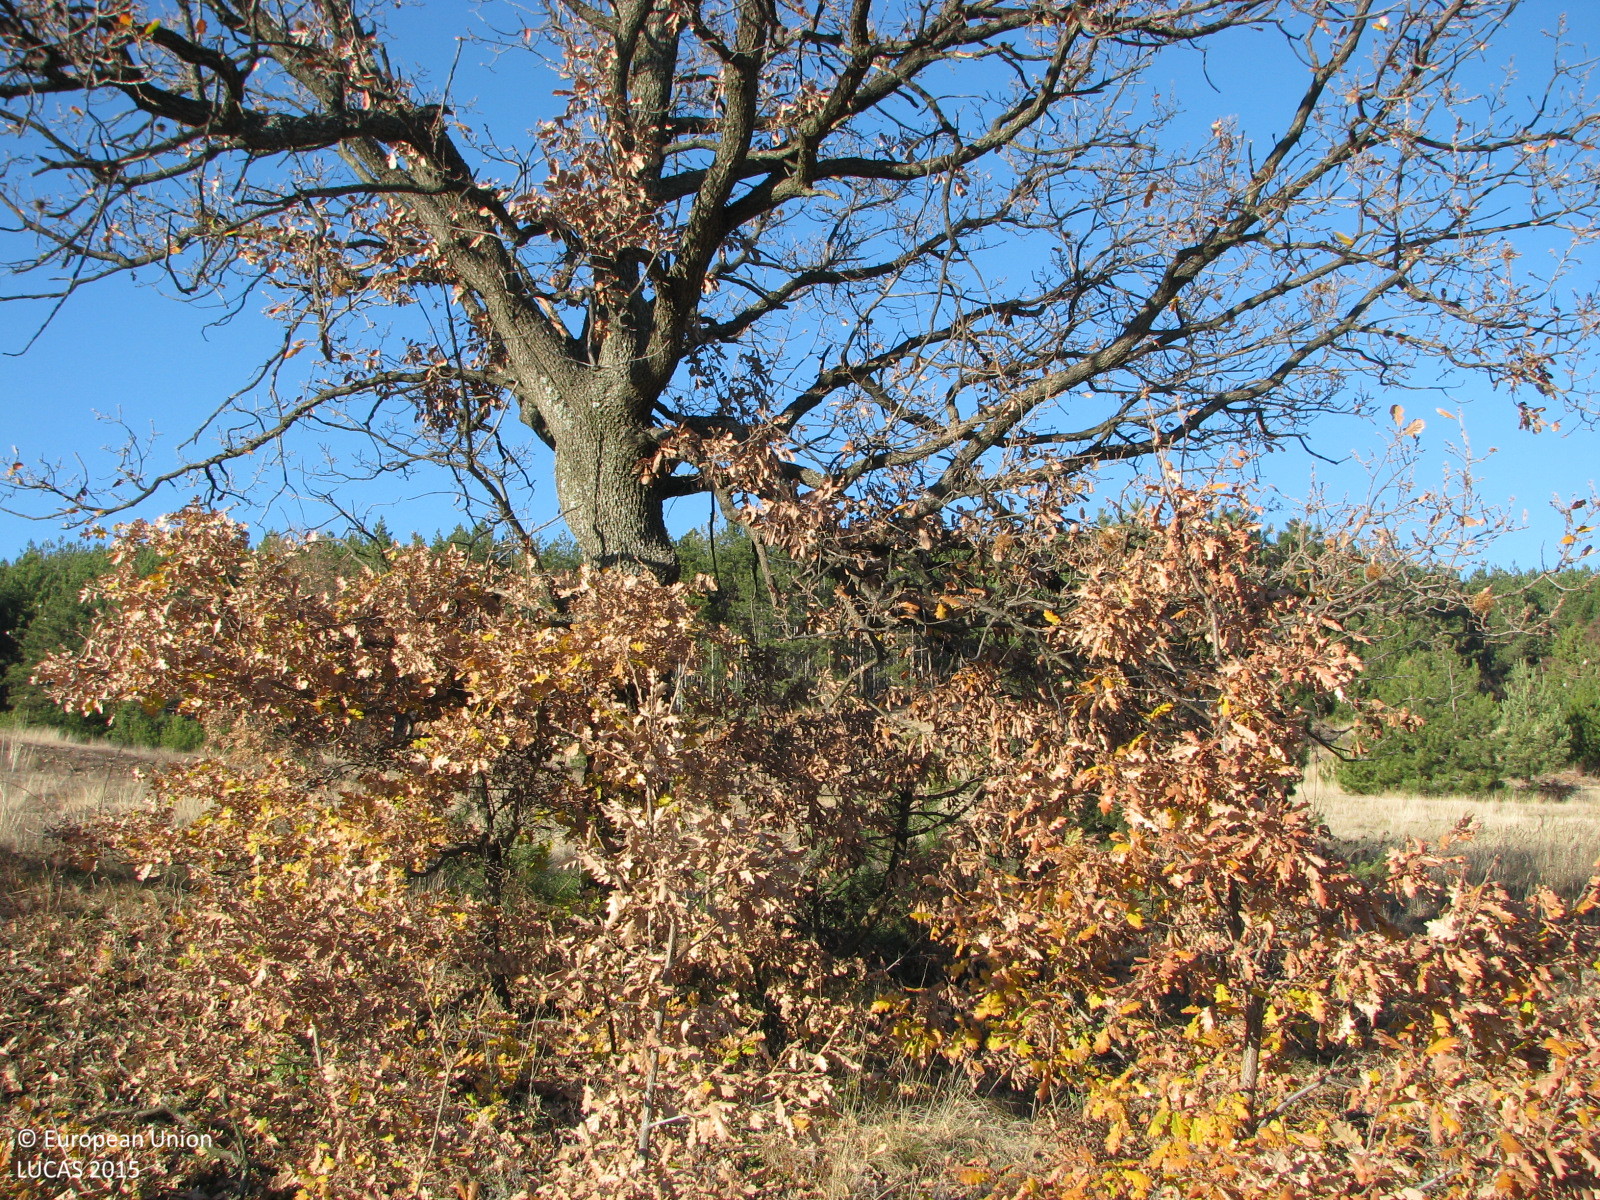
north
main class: Grassland
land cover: Grassland with sparse tree/shrub cover
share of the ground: > 75 %
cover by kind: herbaceous plants 90 %, broadleaved forest trees 5 %, shrubs 5 %
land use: Agriculture (excluding fallow land and kitchen gardens)
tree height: < 5 m
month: December
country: BG
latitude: 42.3809
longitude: 24.1940
